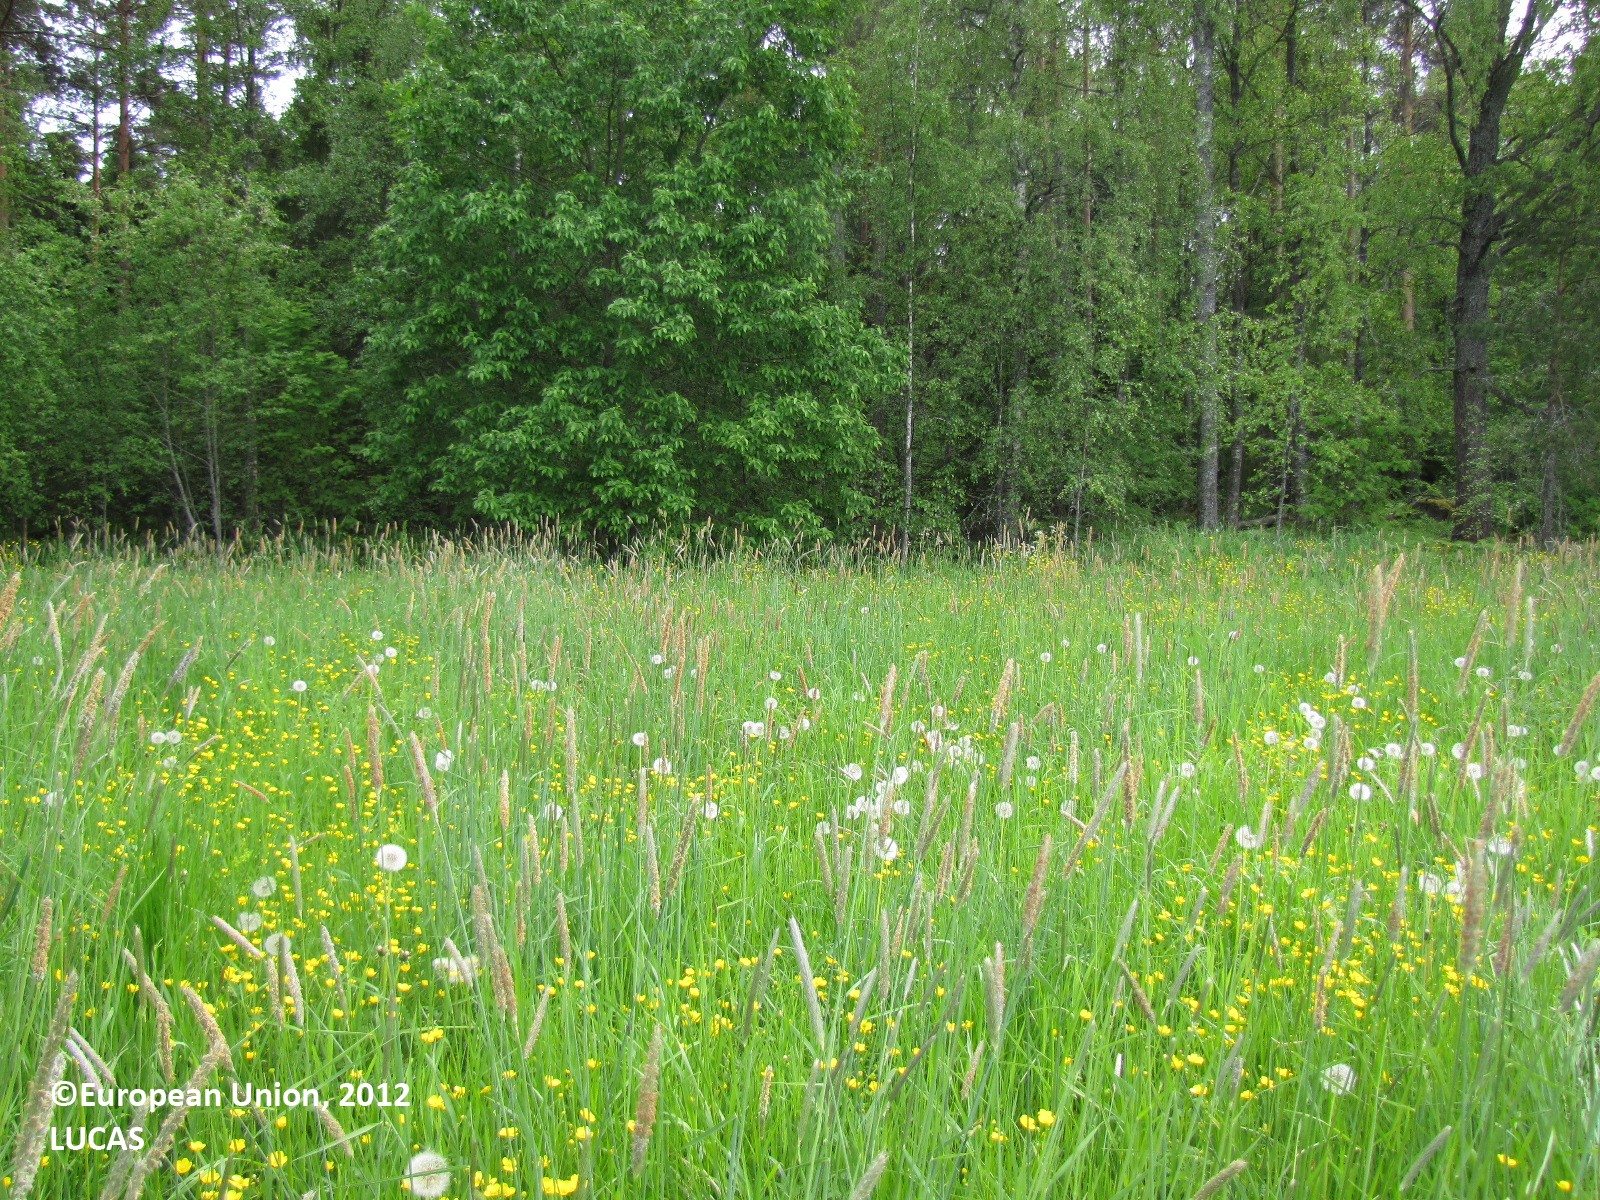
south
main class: Grassland
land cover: Grassland without tree/shrub cover
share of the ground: > 75 %
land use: Residential
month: June
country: FI
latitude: 61.4830
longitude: 24.3086
